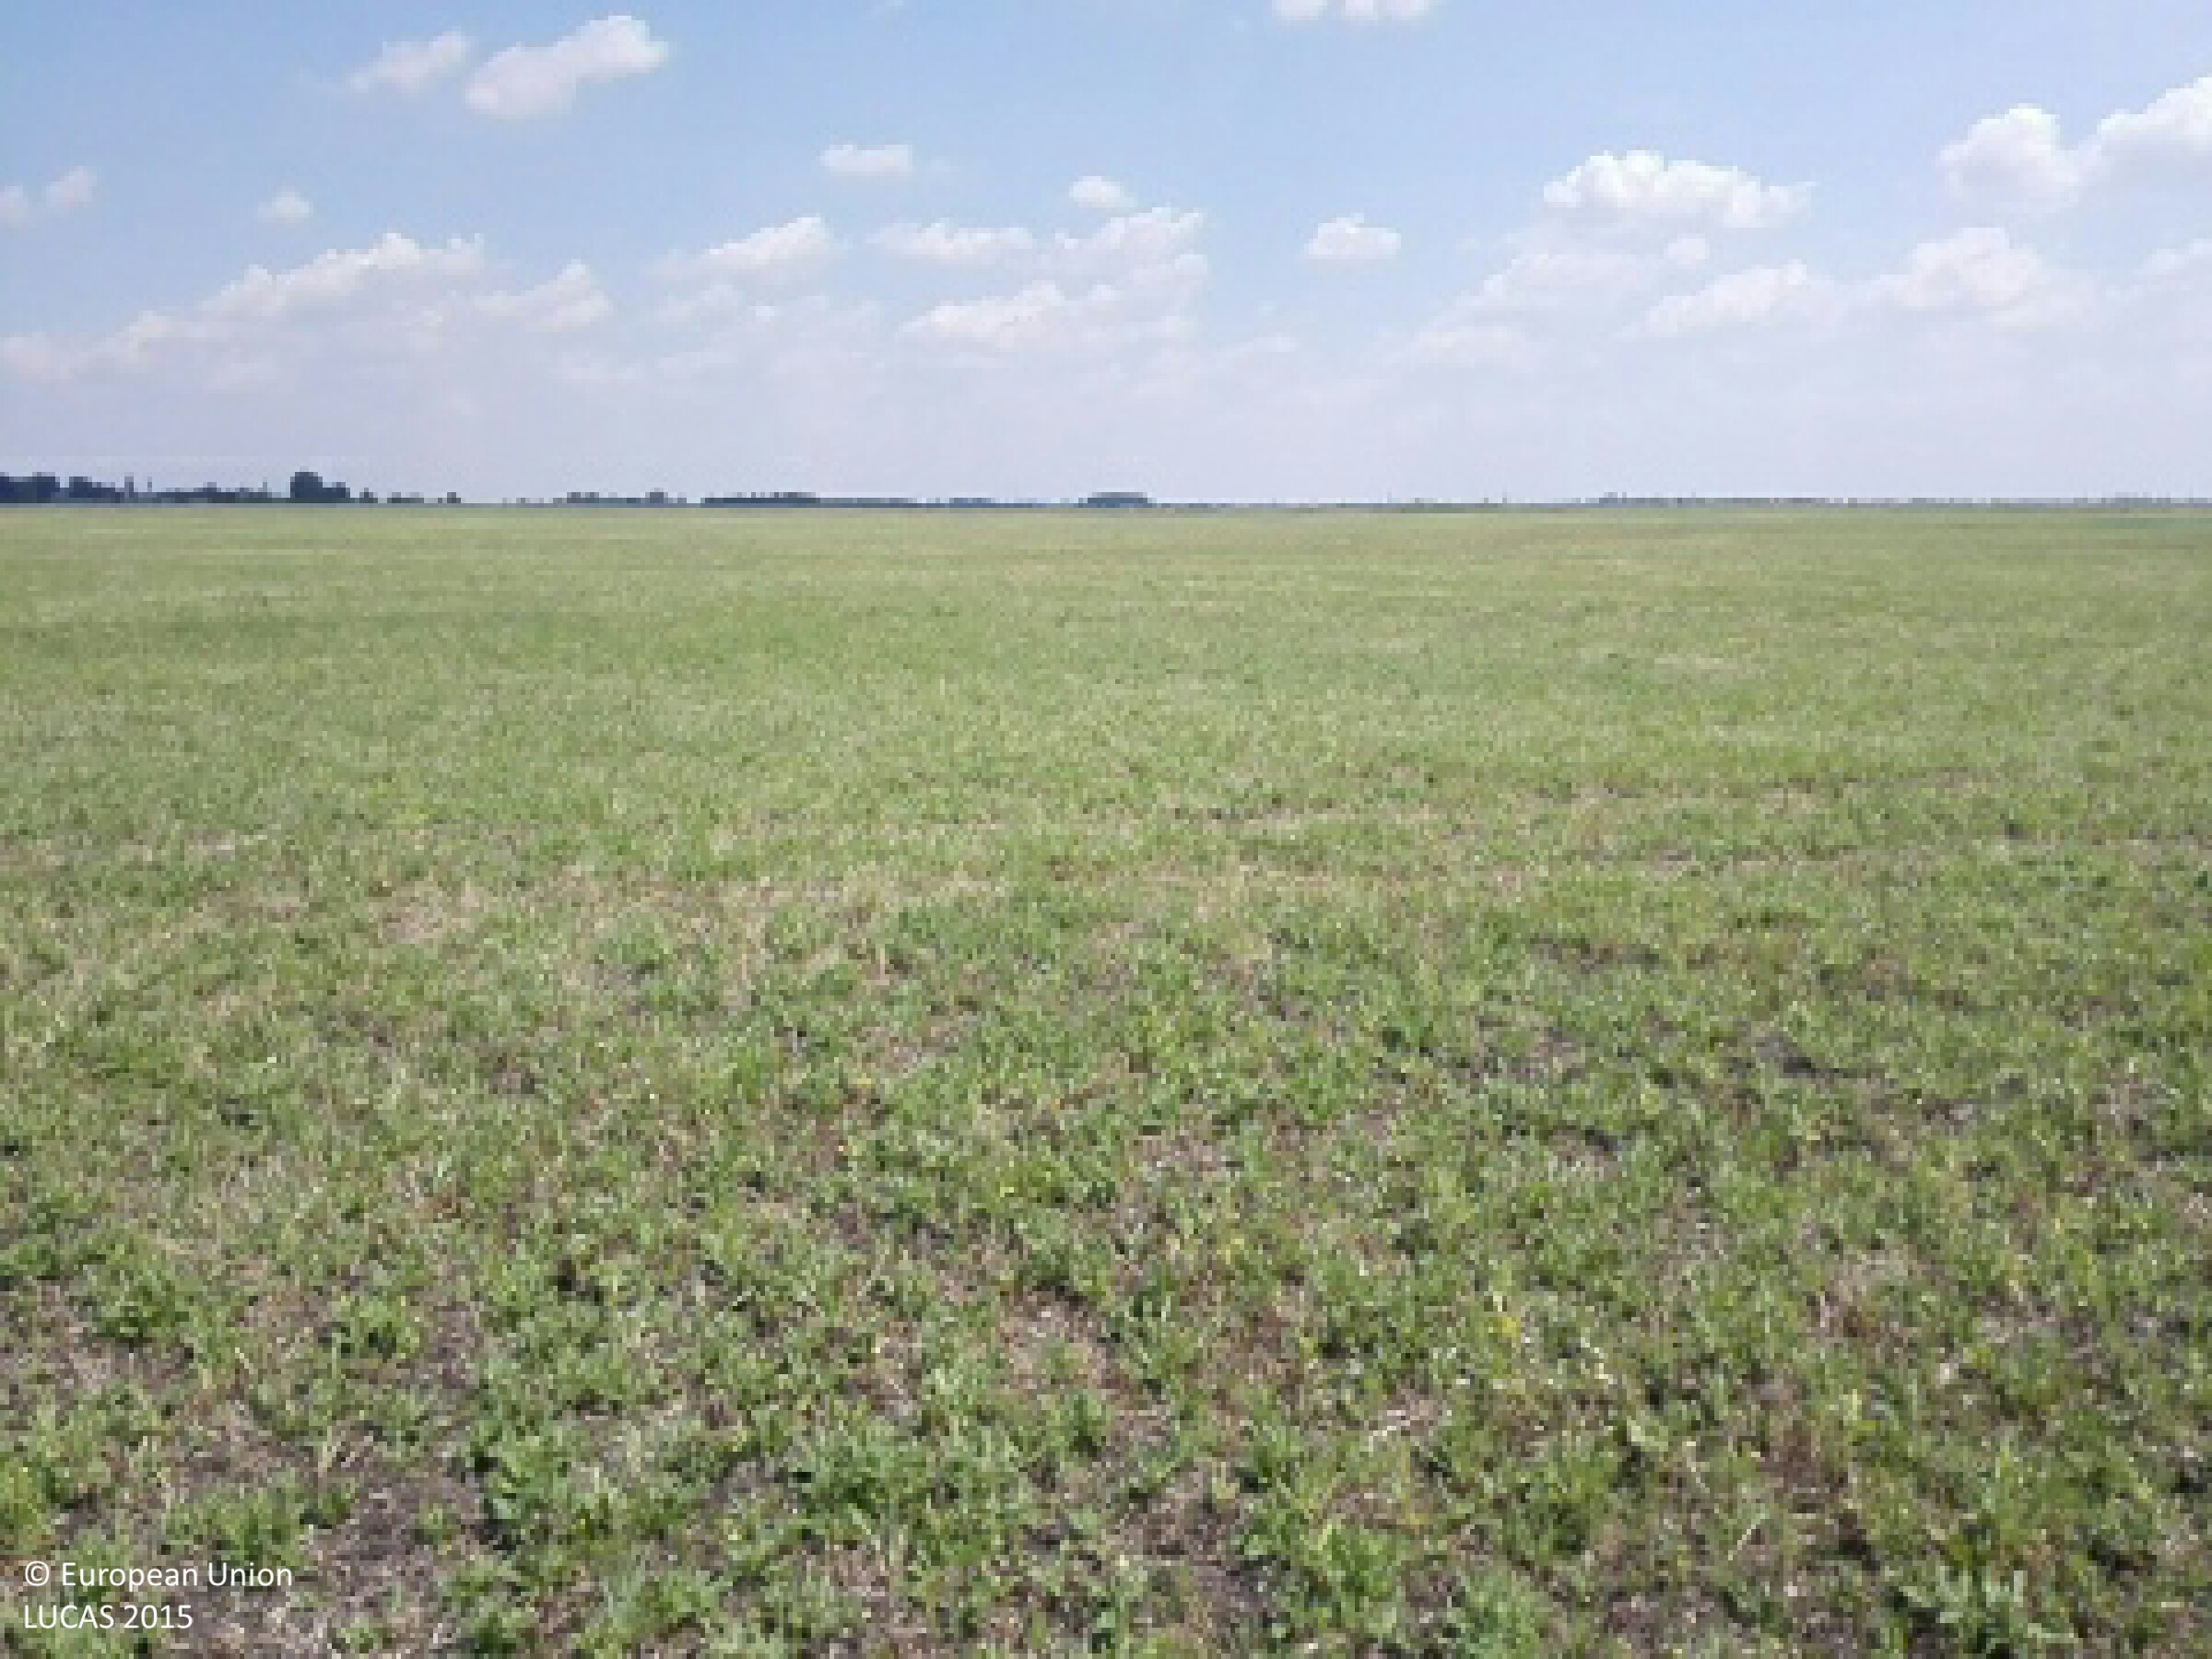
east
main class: Cropland
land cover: Other fibre and oleaginous crops
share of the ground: 50 - 75 %
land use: Agriculture (excluding fallow land and kitchen gardens)
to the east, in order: Other fibre and oleaginous crops
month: July
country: HU
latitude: 47.2960
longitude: 21.2930
